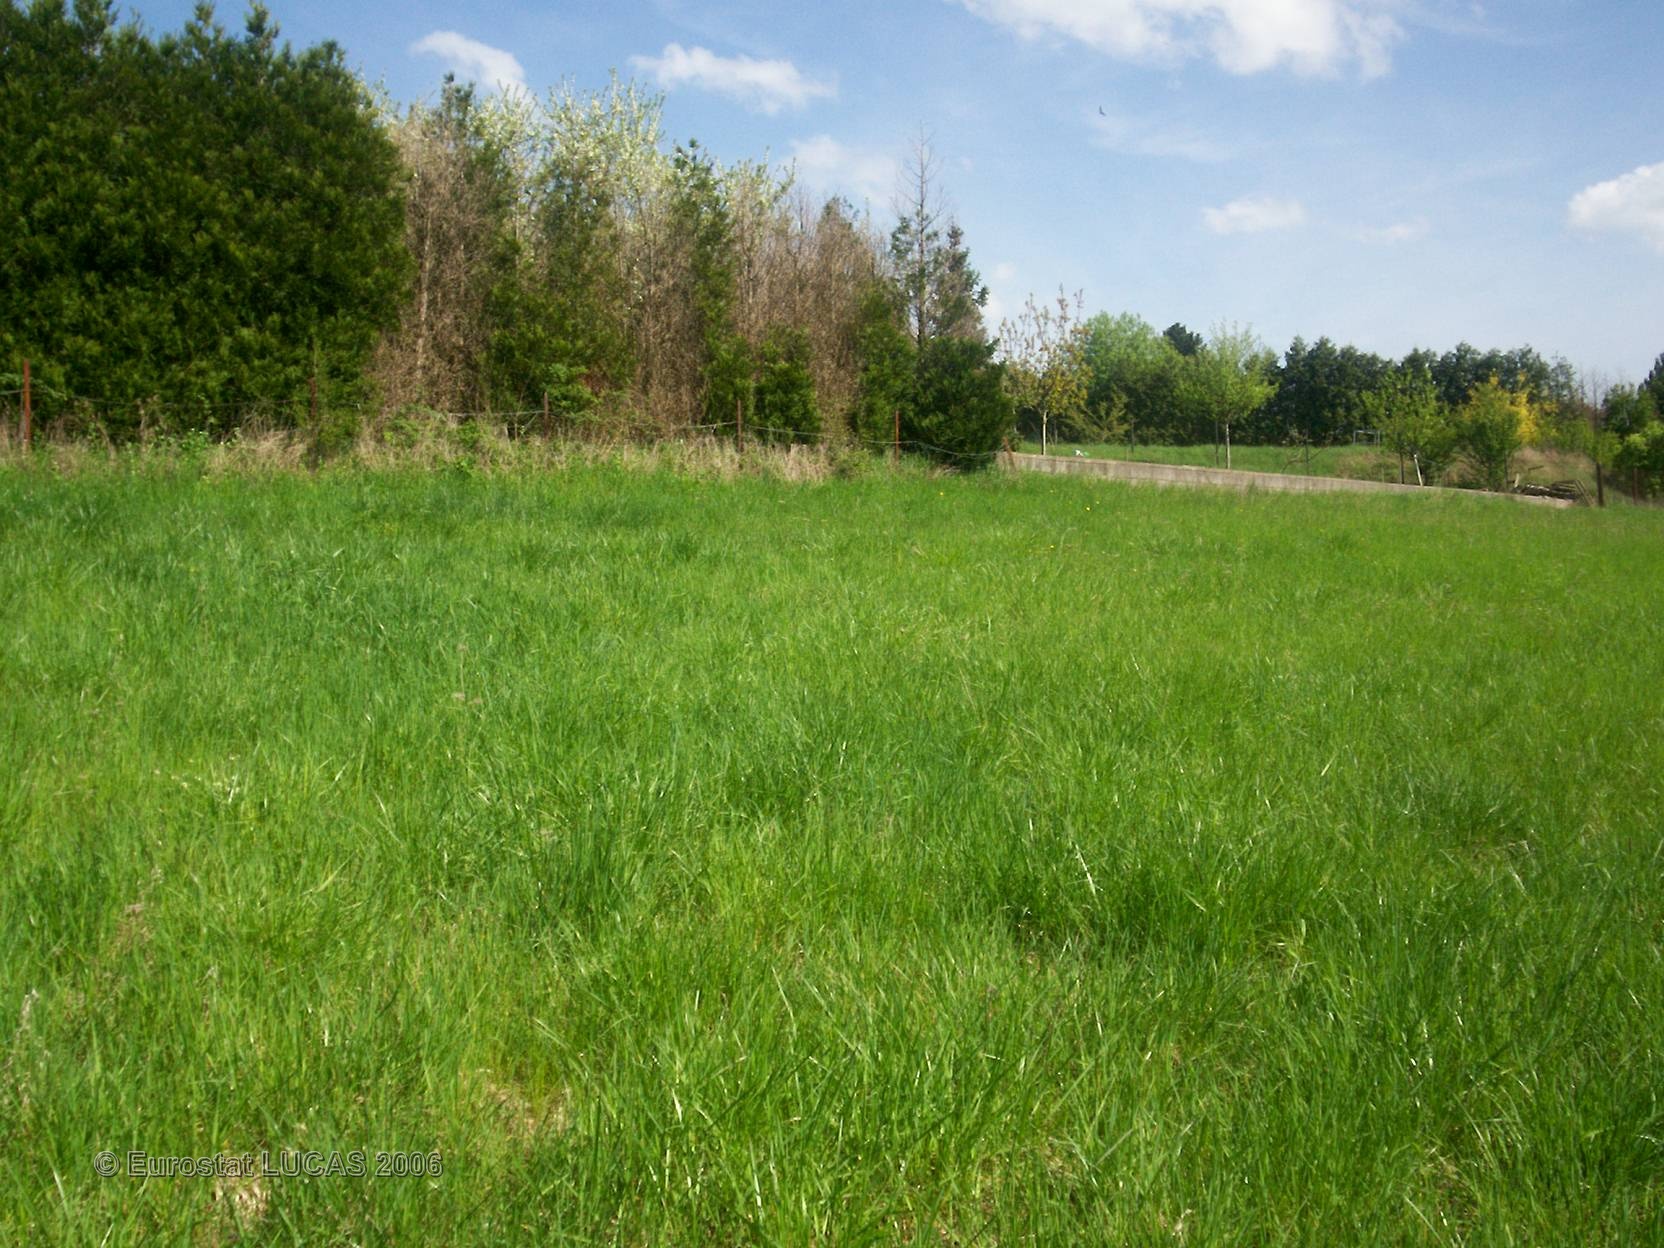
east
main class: Cropland
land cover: Other fruit trees and berries
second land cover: Grassland with sparse tree/shrub cover
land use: Agriculture (excluding fallow land and kitchen gardens)
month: May
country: FR
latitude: 49.0753
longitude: 6.7284
